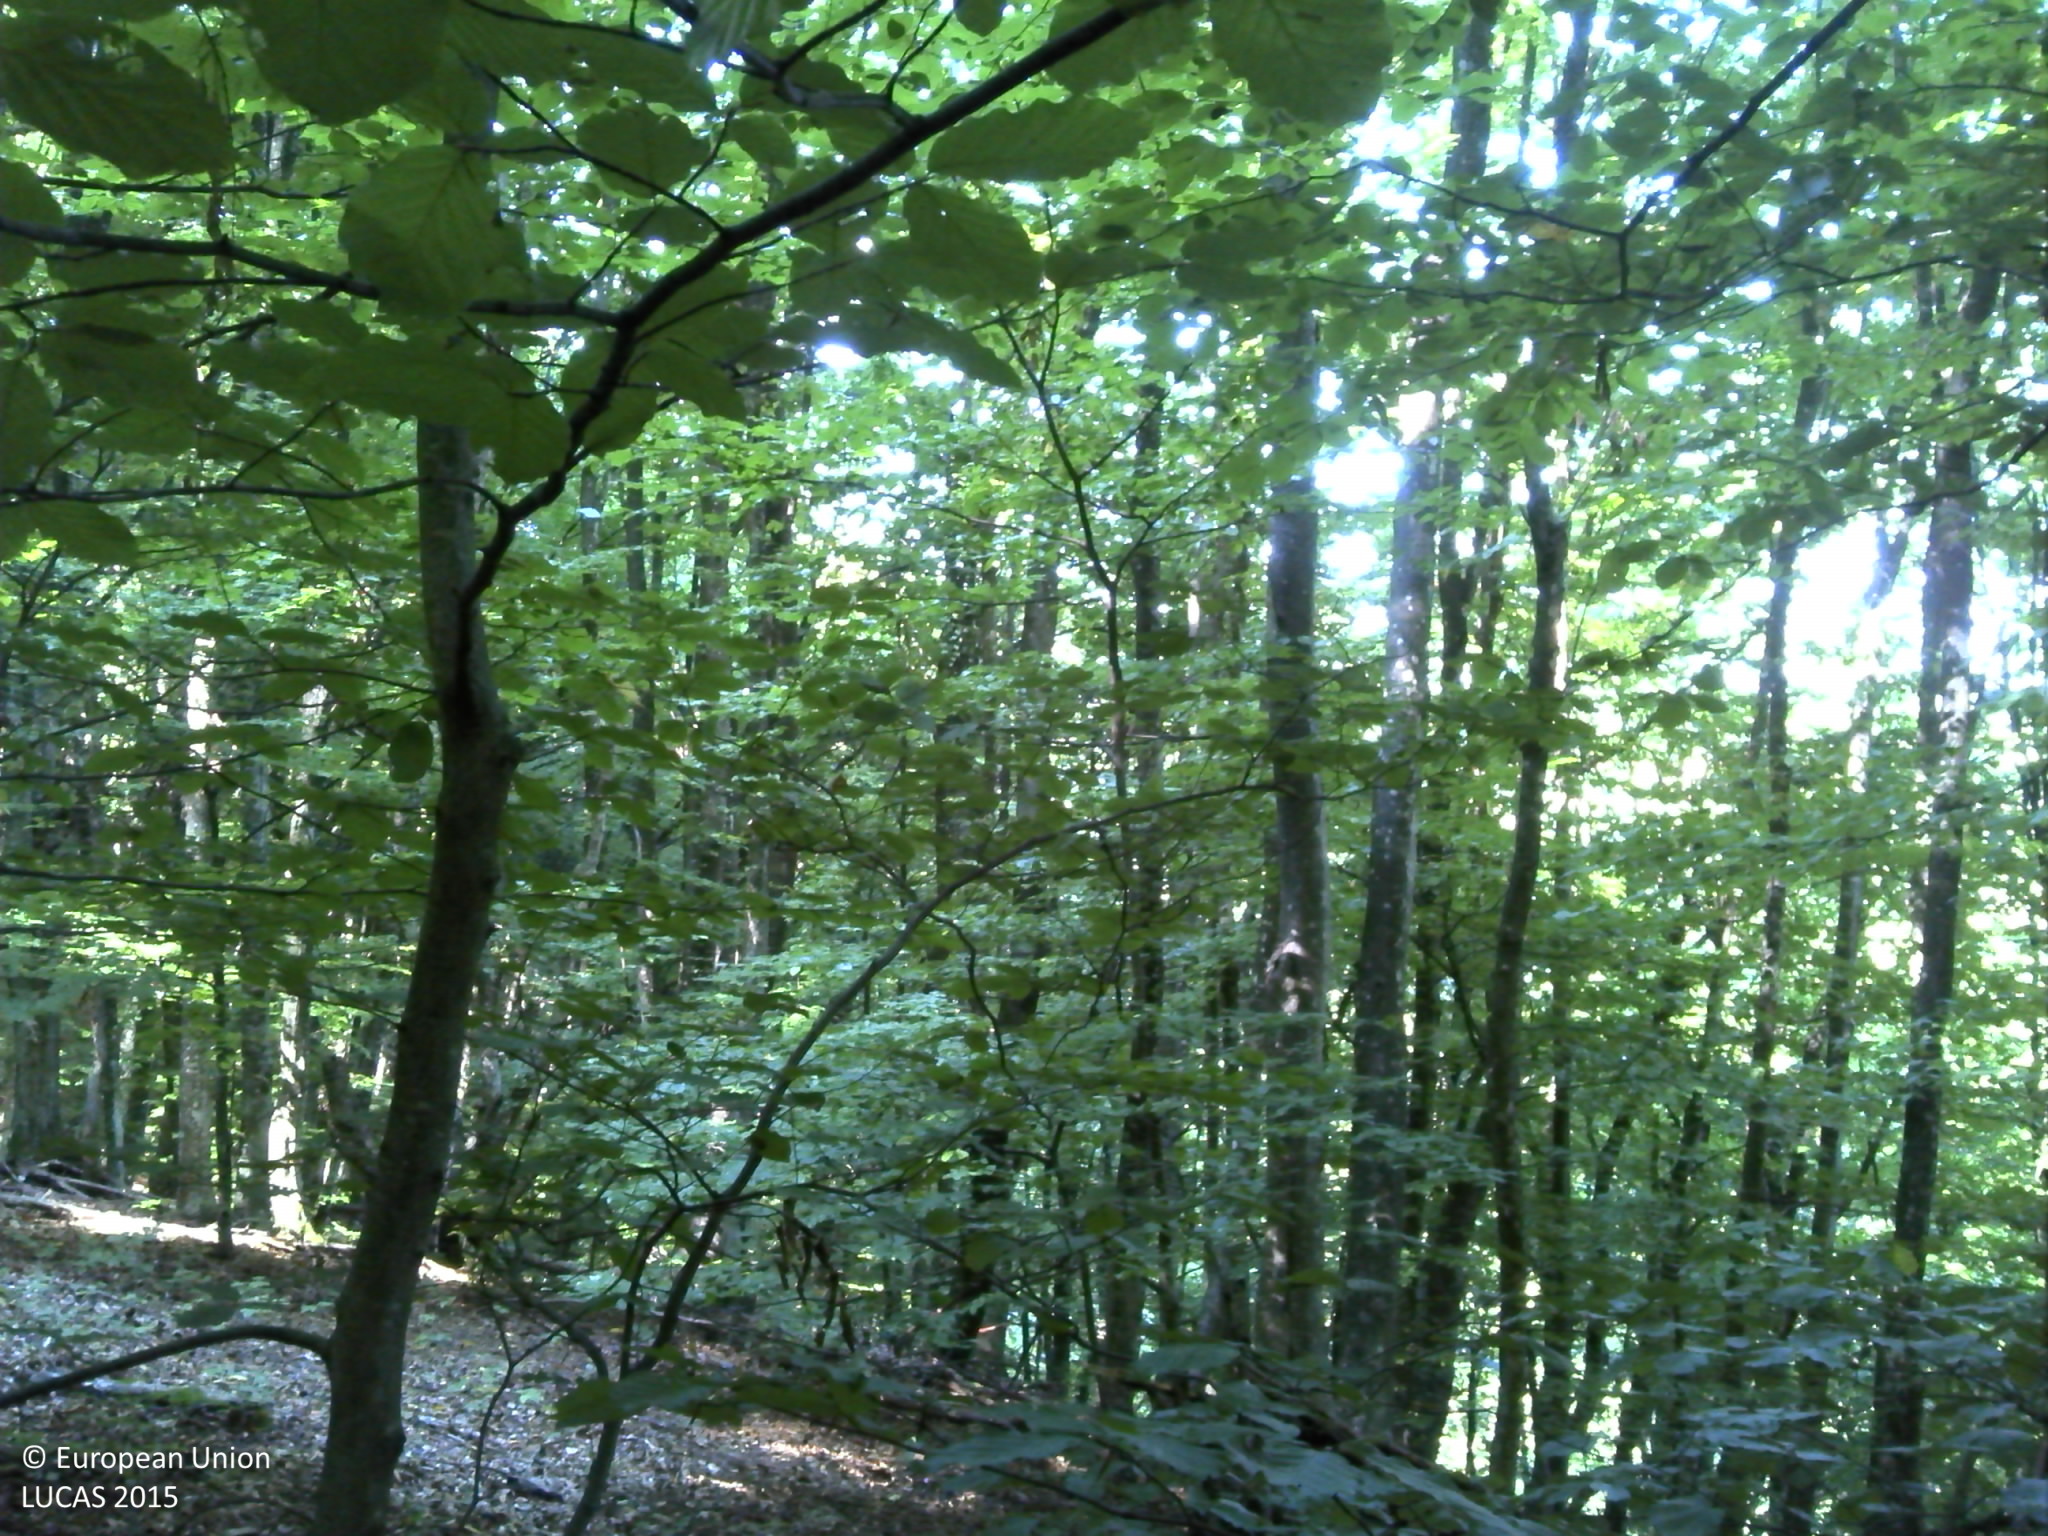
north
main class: Woodland
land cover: Broadleaved woodland
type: beech forest
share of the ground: > 75 %
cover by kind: broadleaved forest trees 100 %
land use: Forestry
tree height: > 5 m
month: August
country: HR
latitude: 45.3144
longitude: 15.6978
